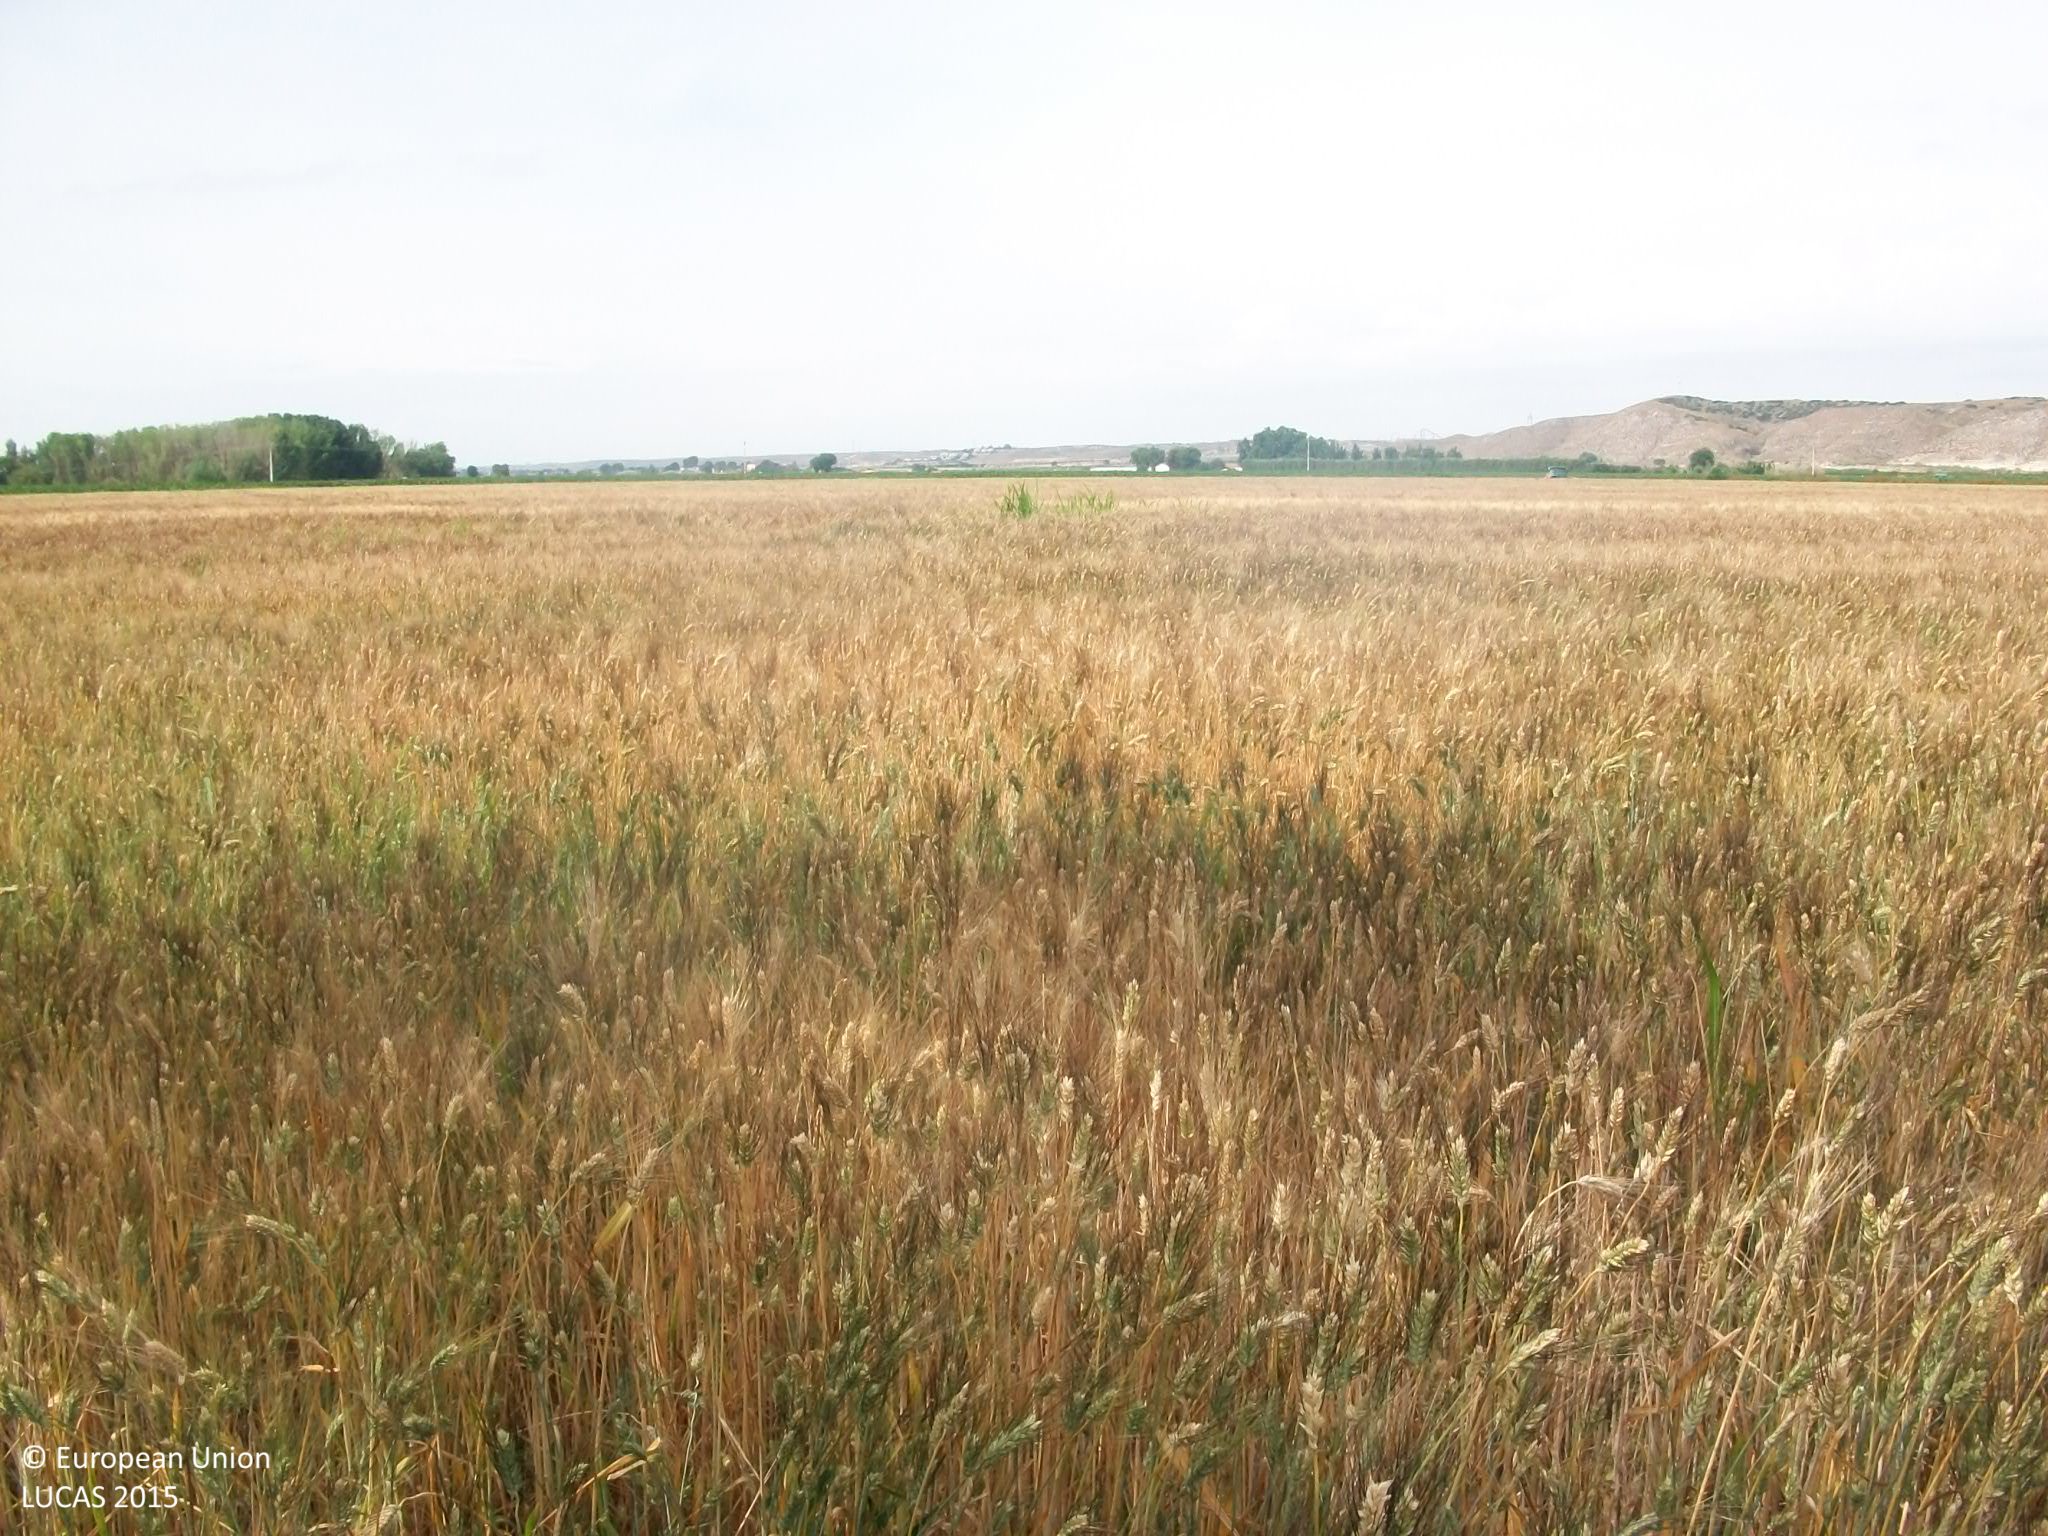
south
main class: Cropland
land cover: Common wheat
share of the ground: > 75 %
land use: Agriculture (excluding fallow land and kitchen gardens)
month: June
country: ES
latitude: 40.2576
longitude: -3.5428
